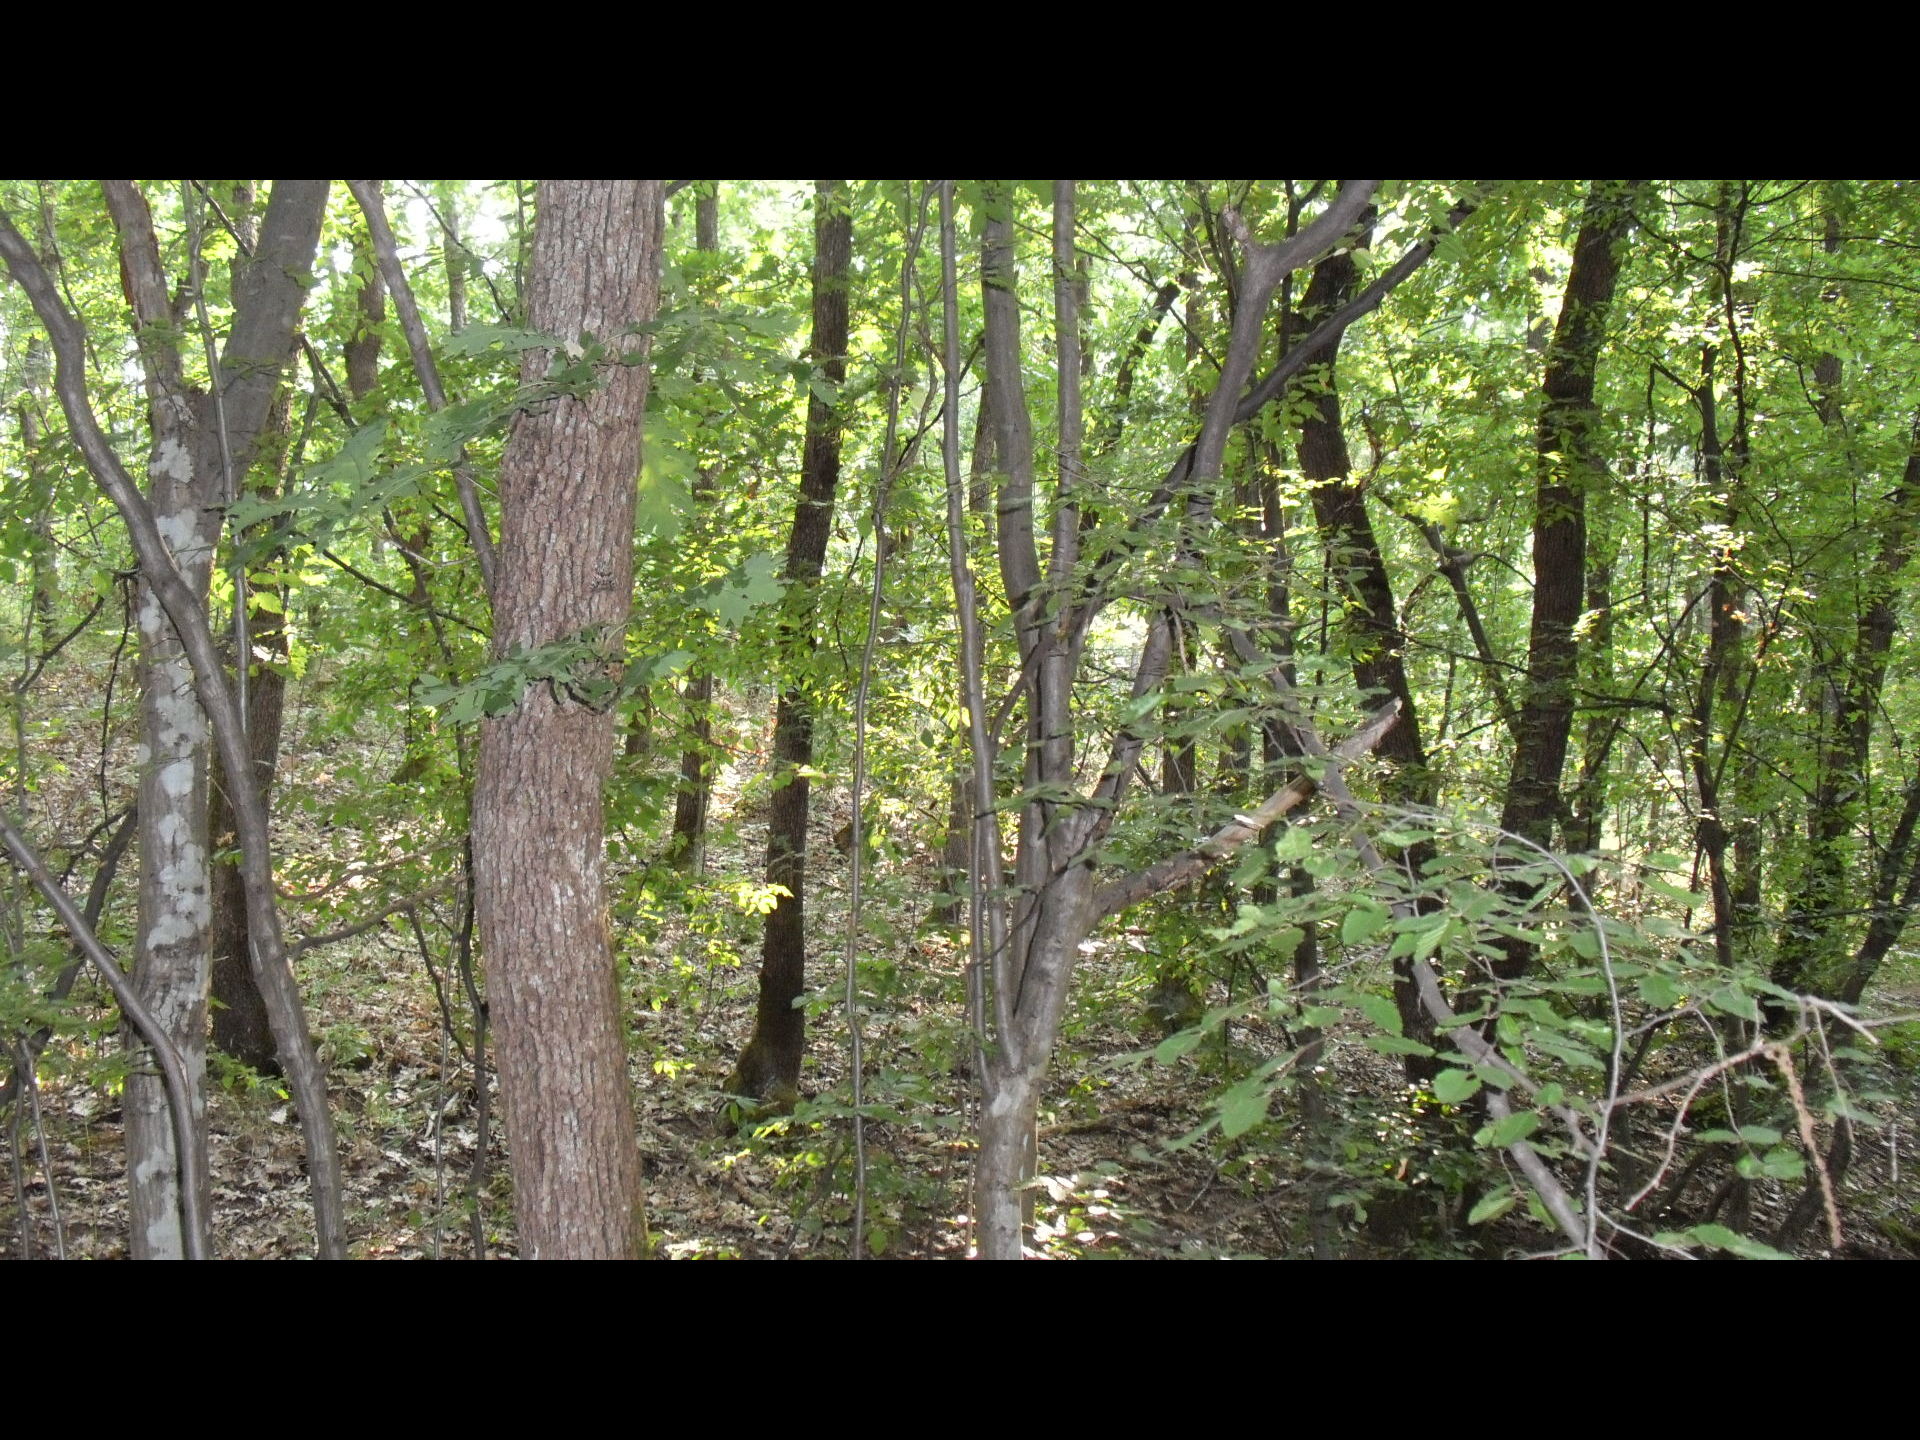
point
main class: Woodland
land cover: Broadleaved woodland
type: mesophytic deciduous forest
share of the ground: > 75 %
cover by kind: broadleaved forest trees 95 %, shrubs 5 %
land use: Forestry
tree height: > 5 m
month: July
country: BG
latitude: 43.6941
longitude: 22.7025
